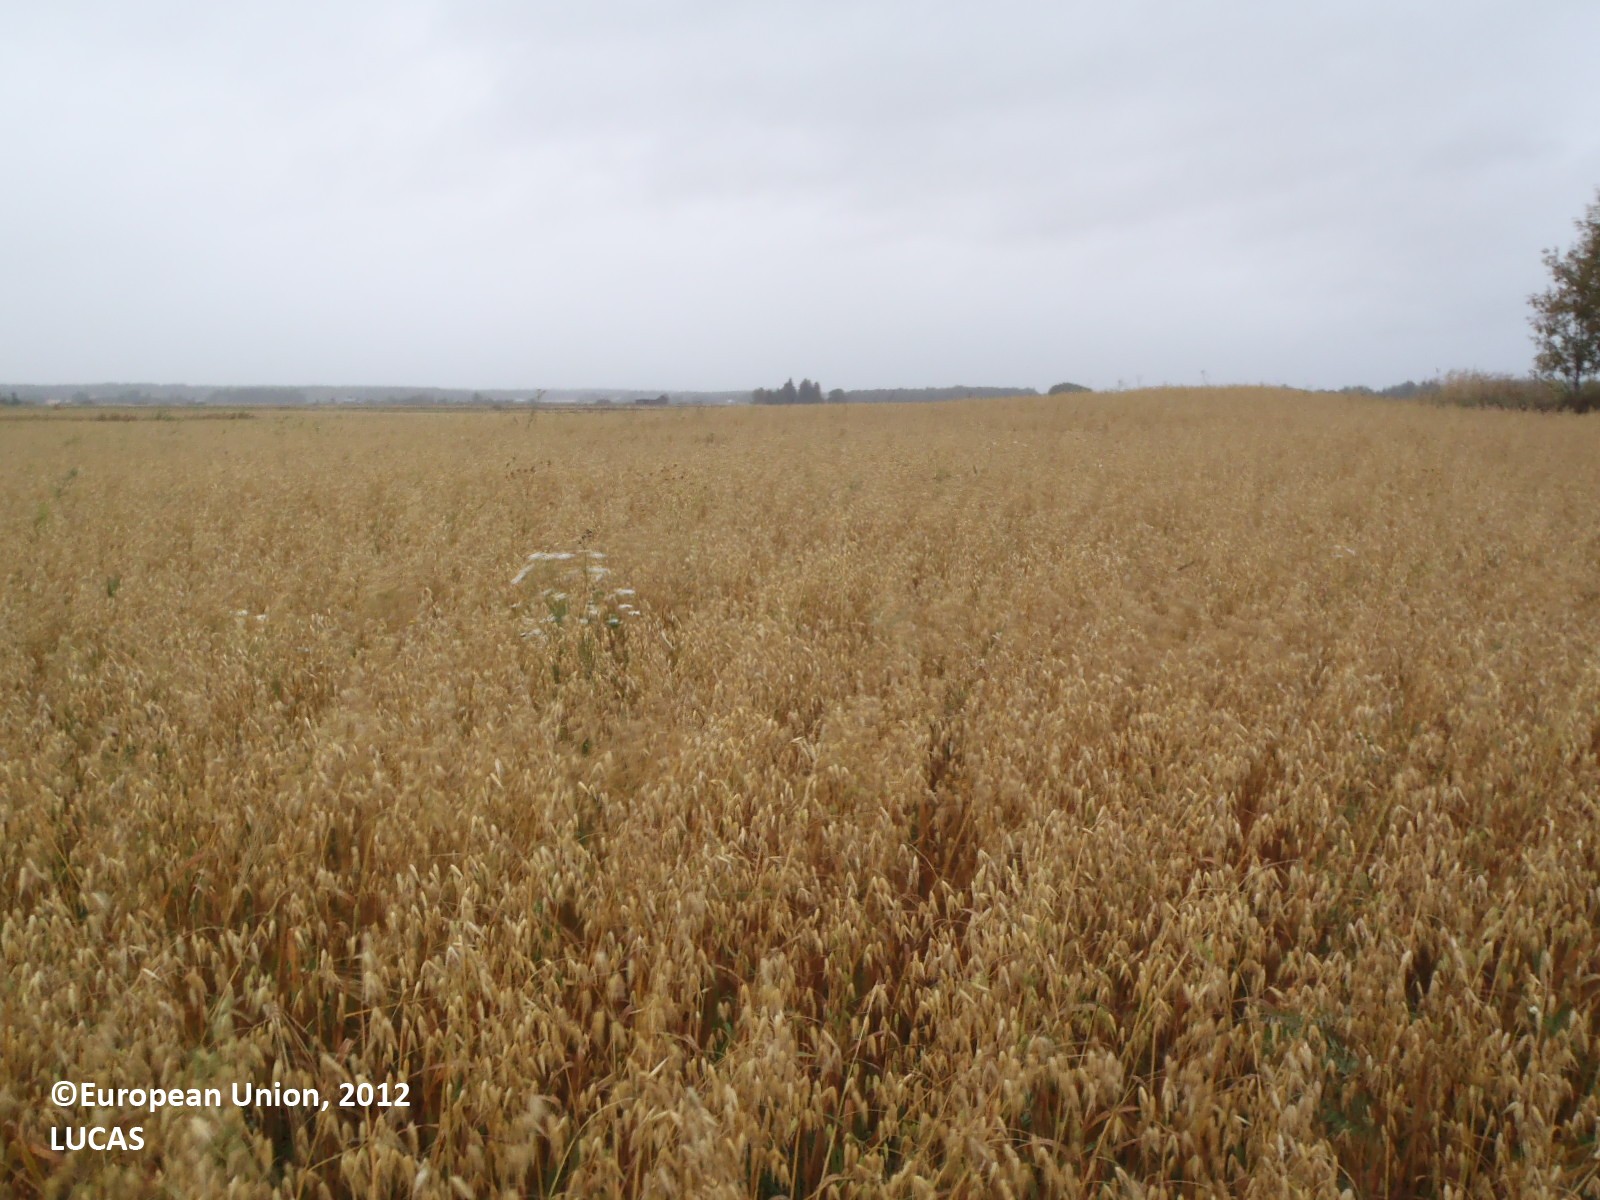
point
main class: Cropland
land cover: Oats
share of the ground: > 75 %
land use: Agriculture (excluding fallow land and kitchen gardens)
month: September
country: FI
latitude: 61.2499
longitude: 22.6855
